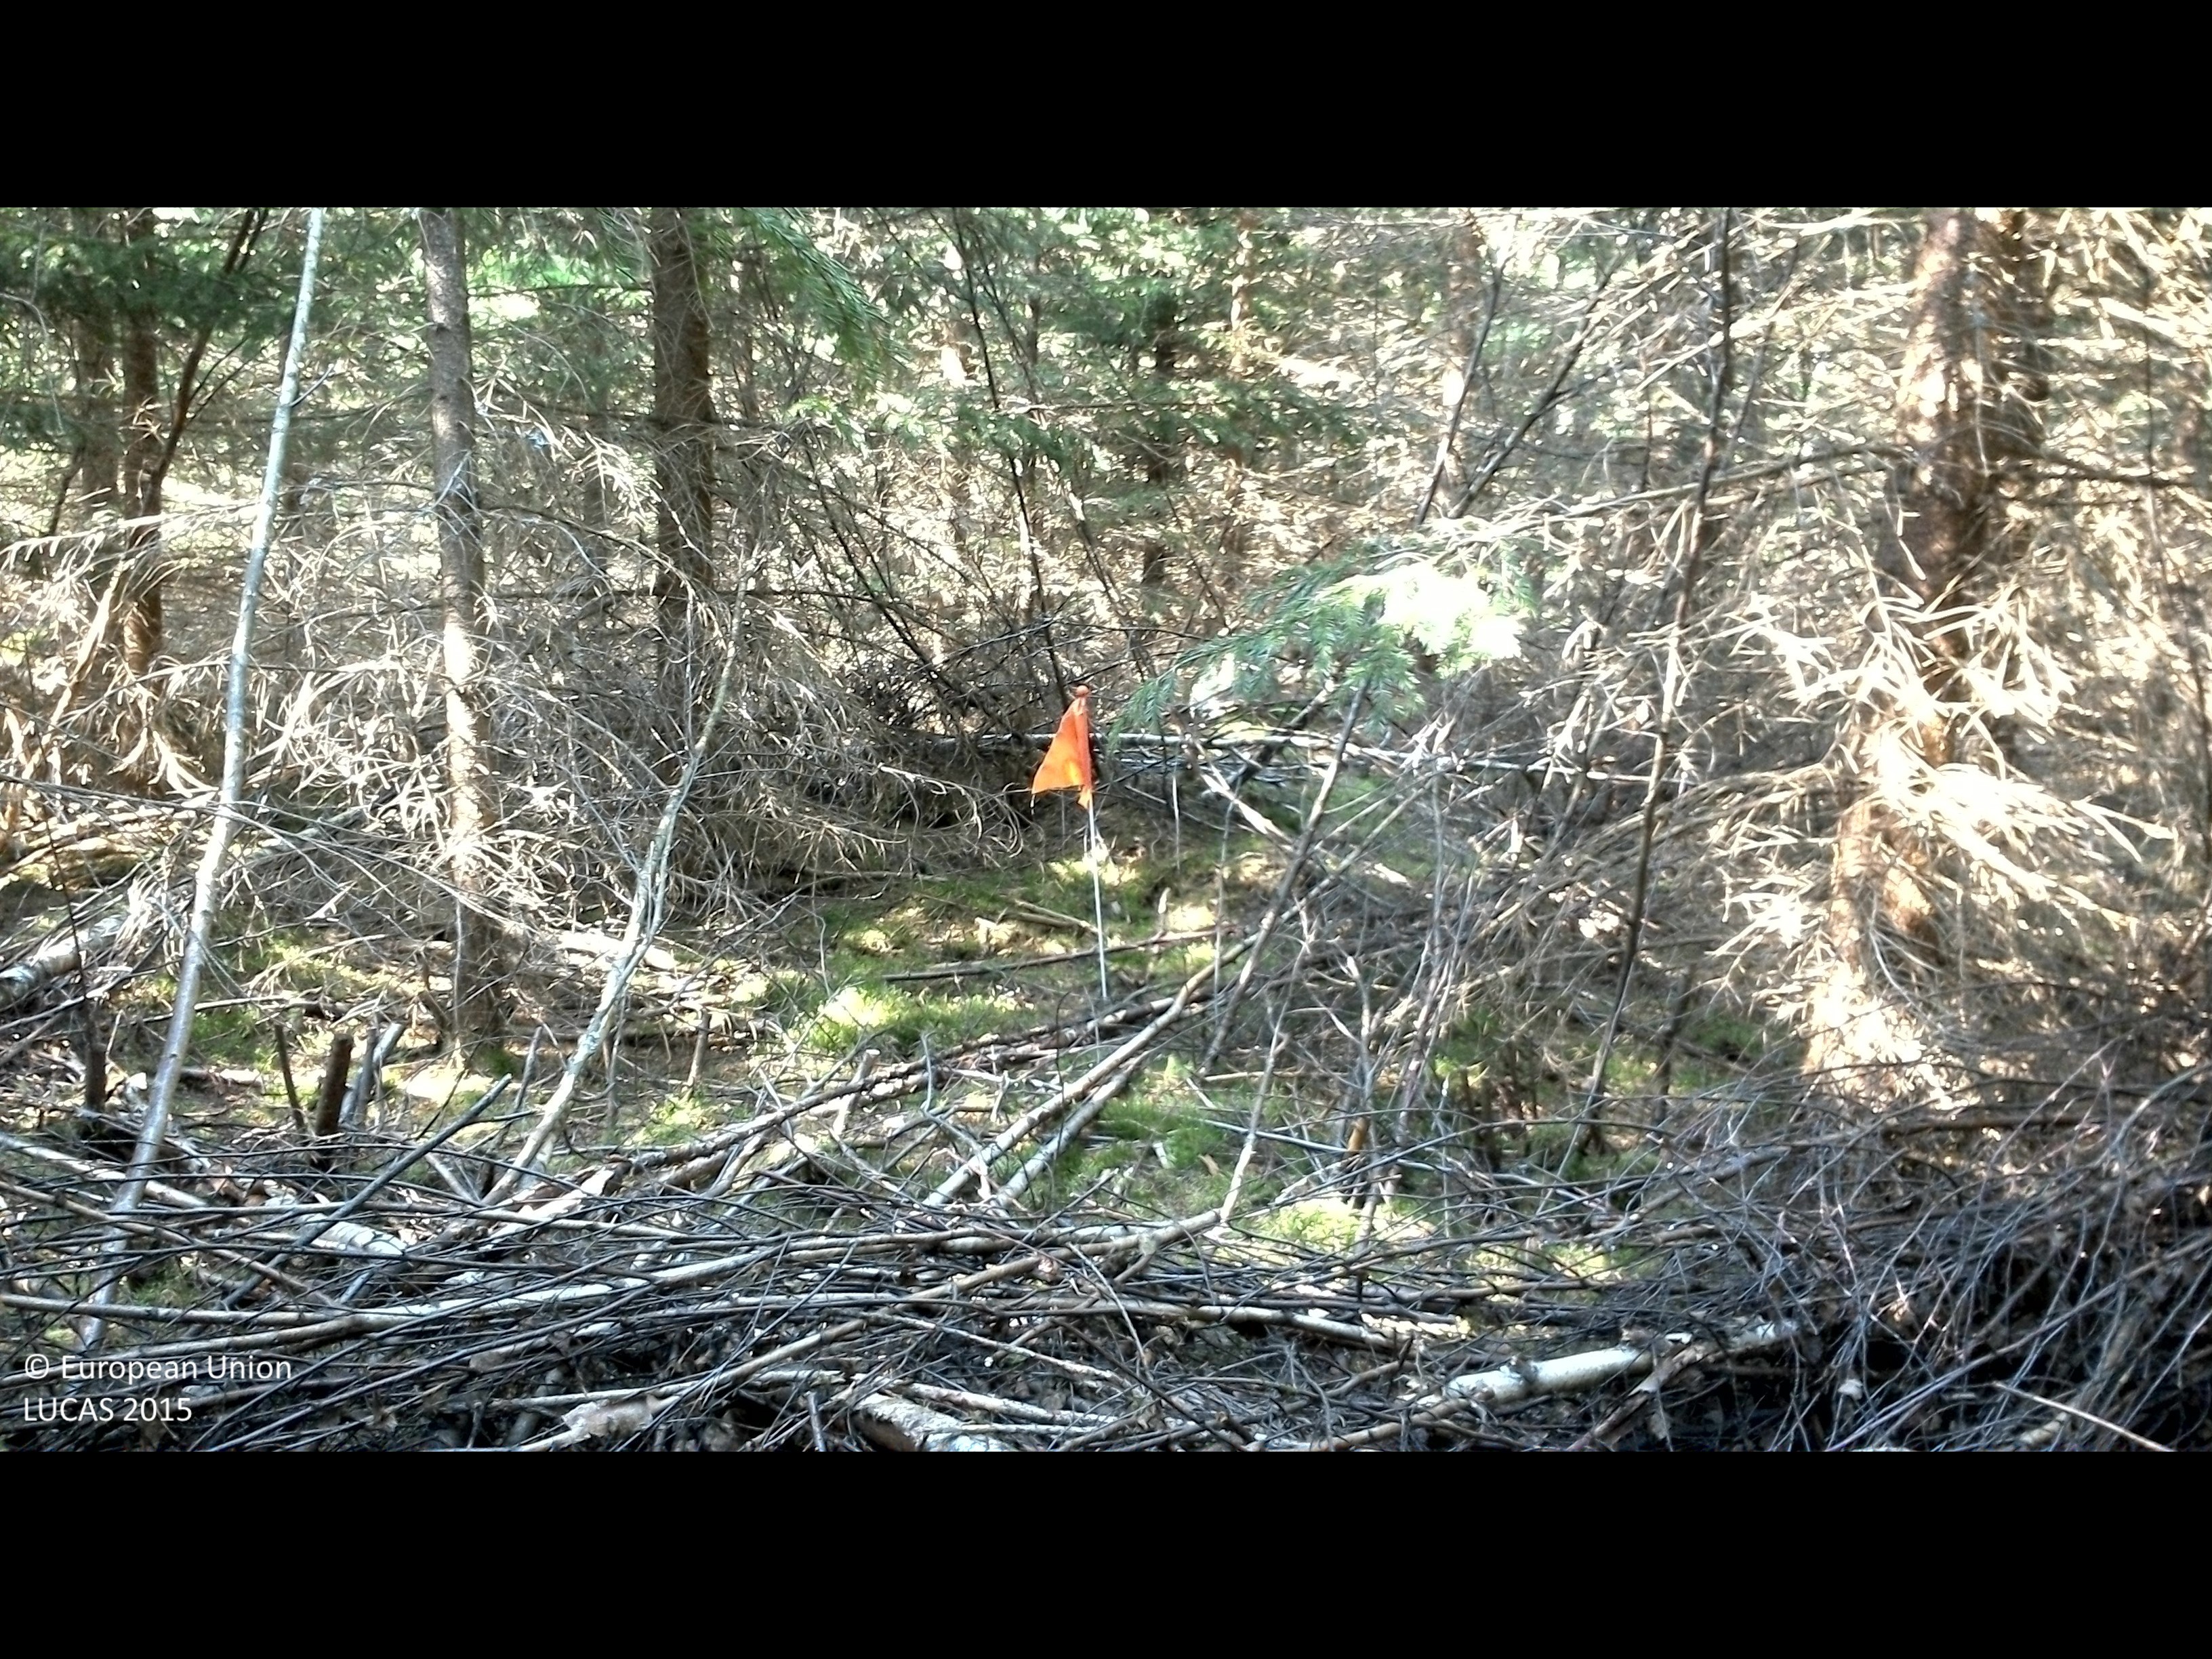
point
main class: Woodland
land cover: Spruce dominated coniferous woodland
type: boreal forest
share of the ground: > 75 %
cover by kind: coniferous forest trees 90 %, lichens and mosses 10 %
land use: Forestry
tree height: > 5 m
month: July
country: SE
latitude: 56.4285
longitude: 15.1061
